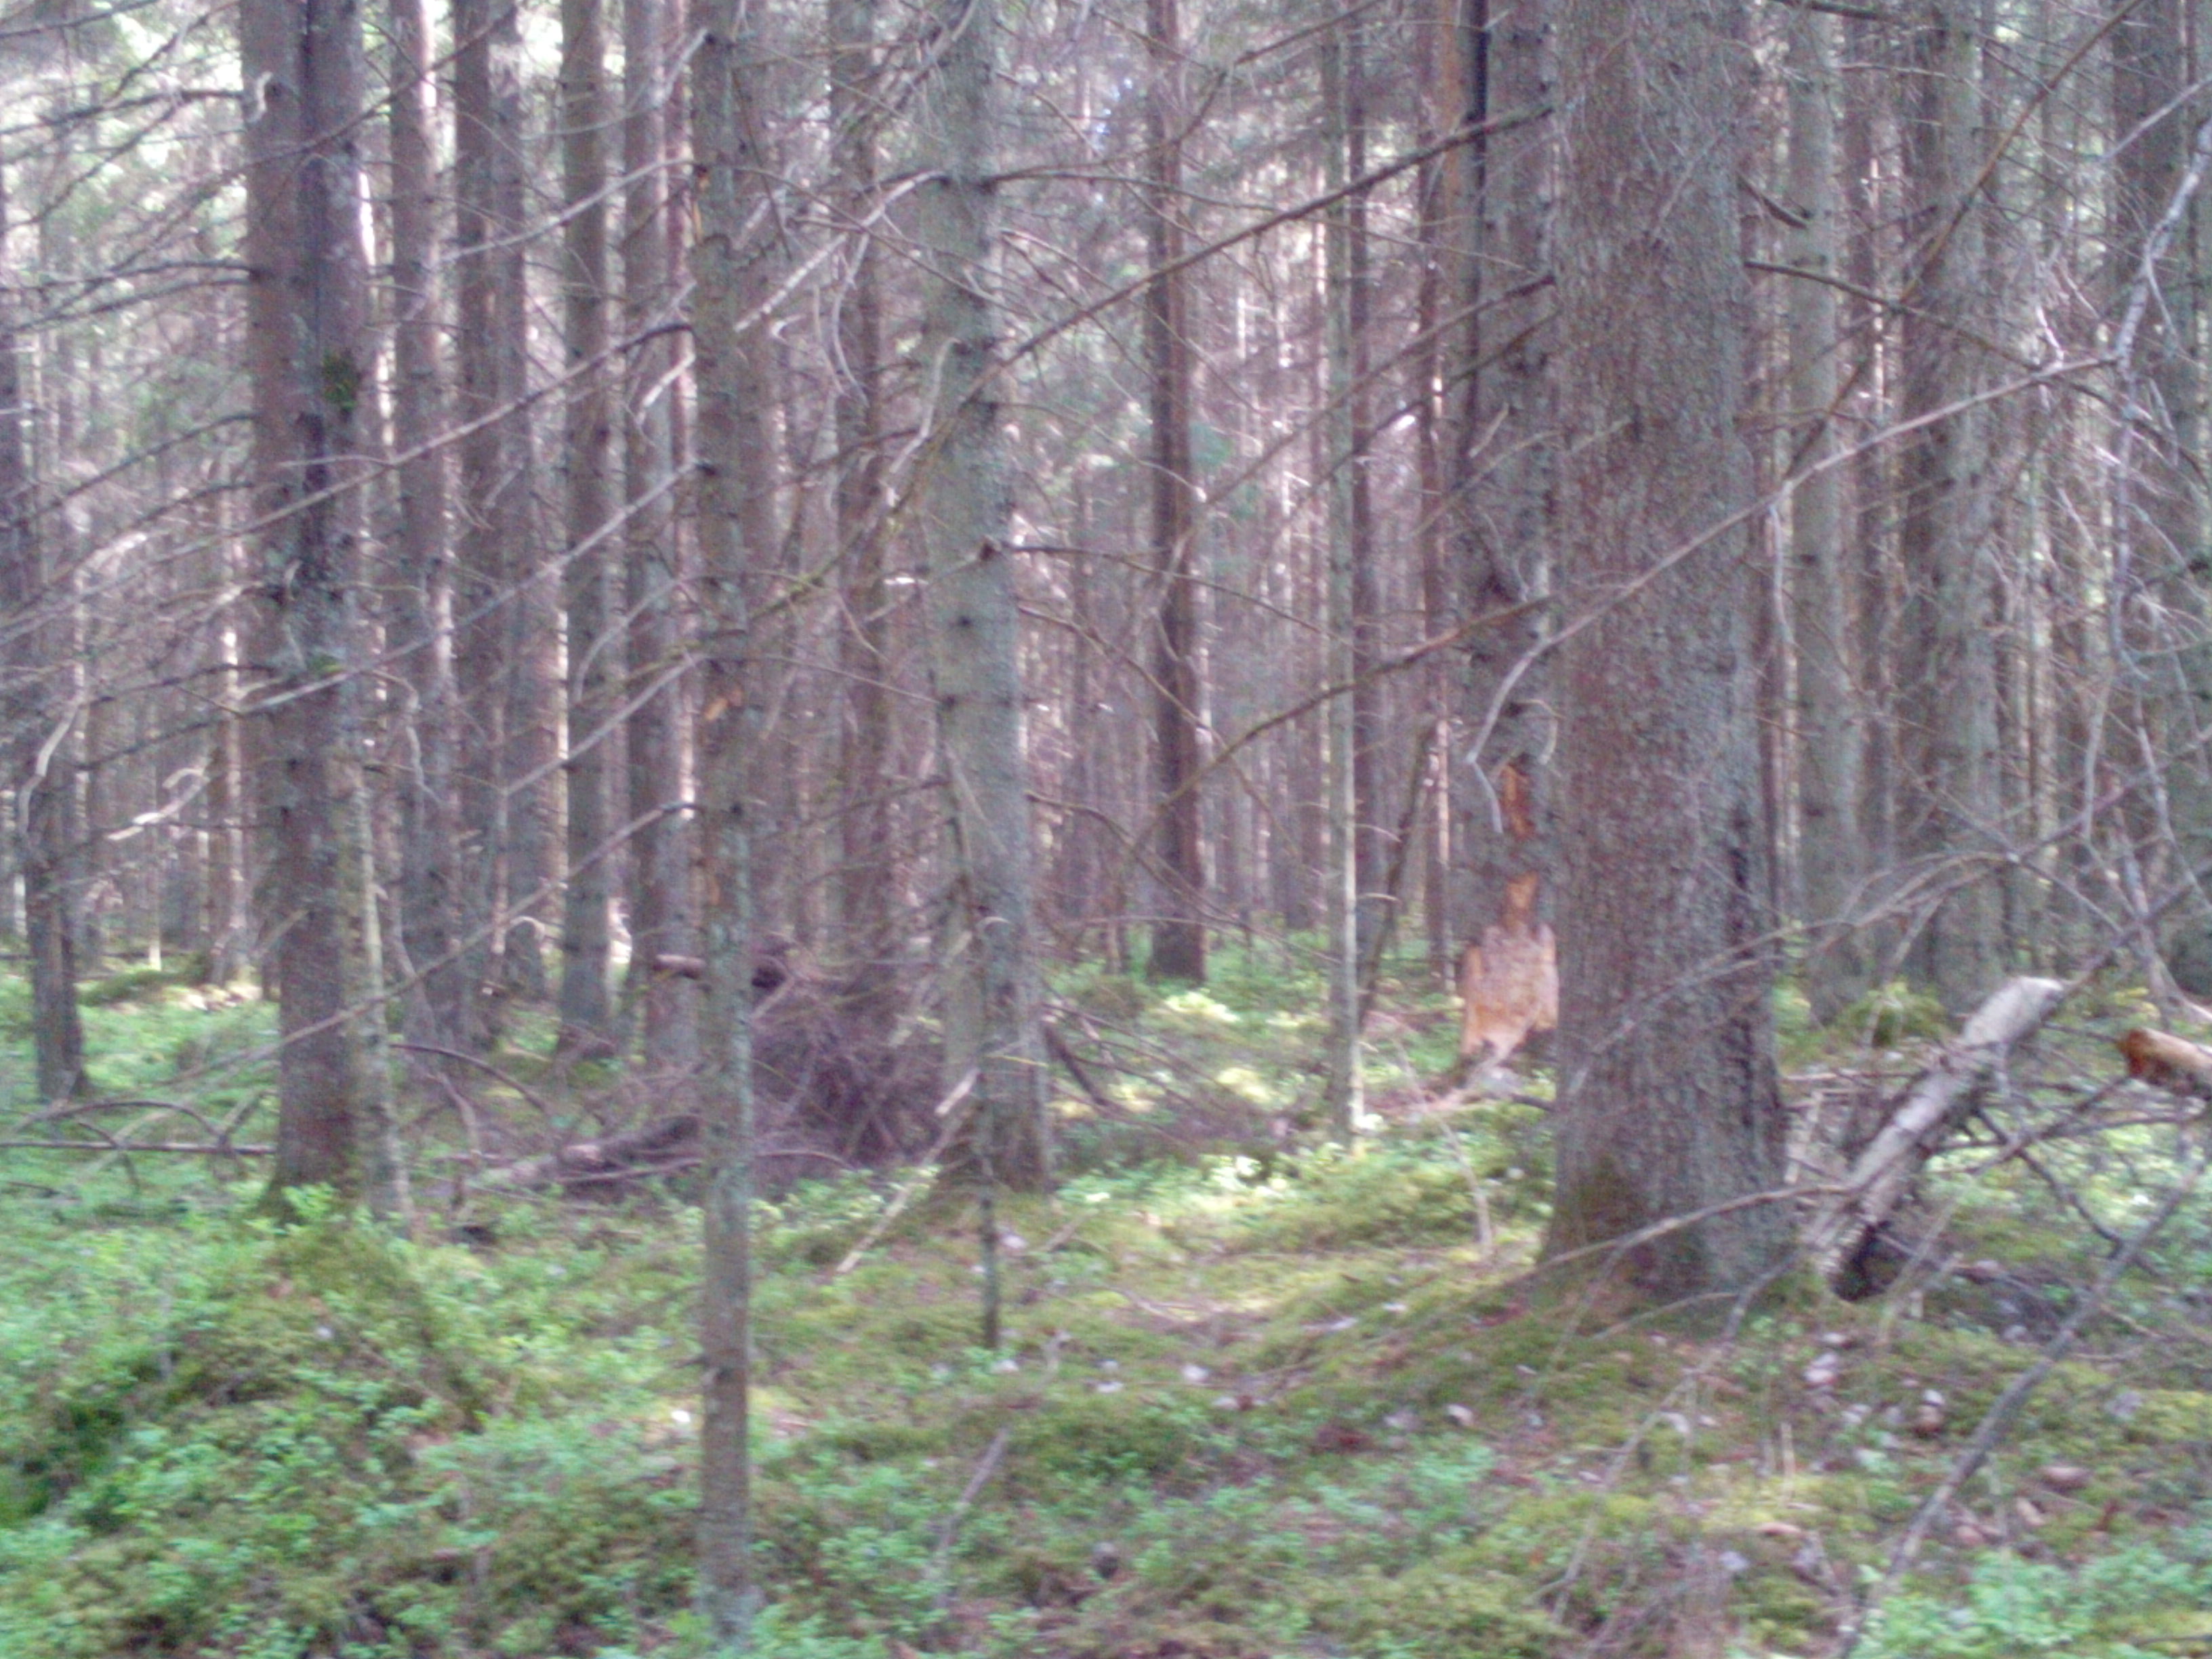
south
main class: Woodland
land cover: Spruce dominated coniferous woodland
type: hemiboreal forest and nemoral coniferous forest and mixed broadleaved-coniferous forest
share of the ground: > 75 %
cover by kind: coniferous forest trees 90 %, herbaceous plants 5 %, lichens and mosses 5 %
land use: Forestry
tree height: > 5 m
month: May
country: LV
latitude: 56.5550
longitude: 22.3374
